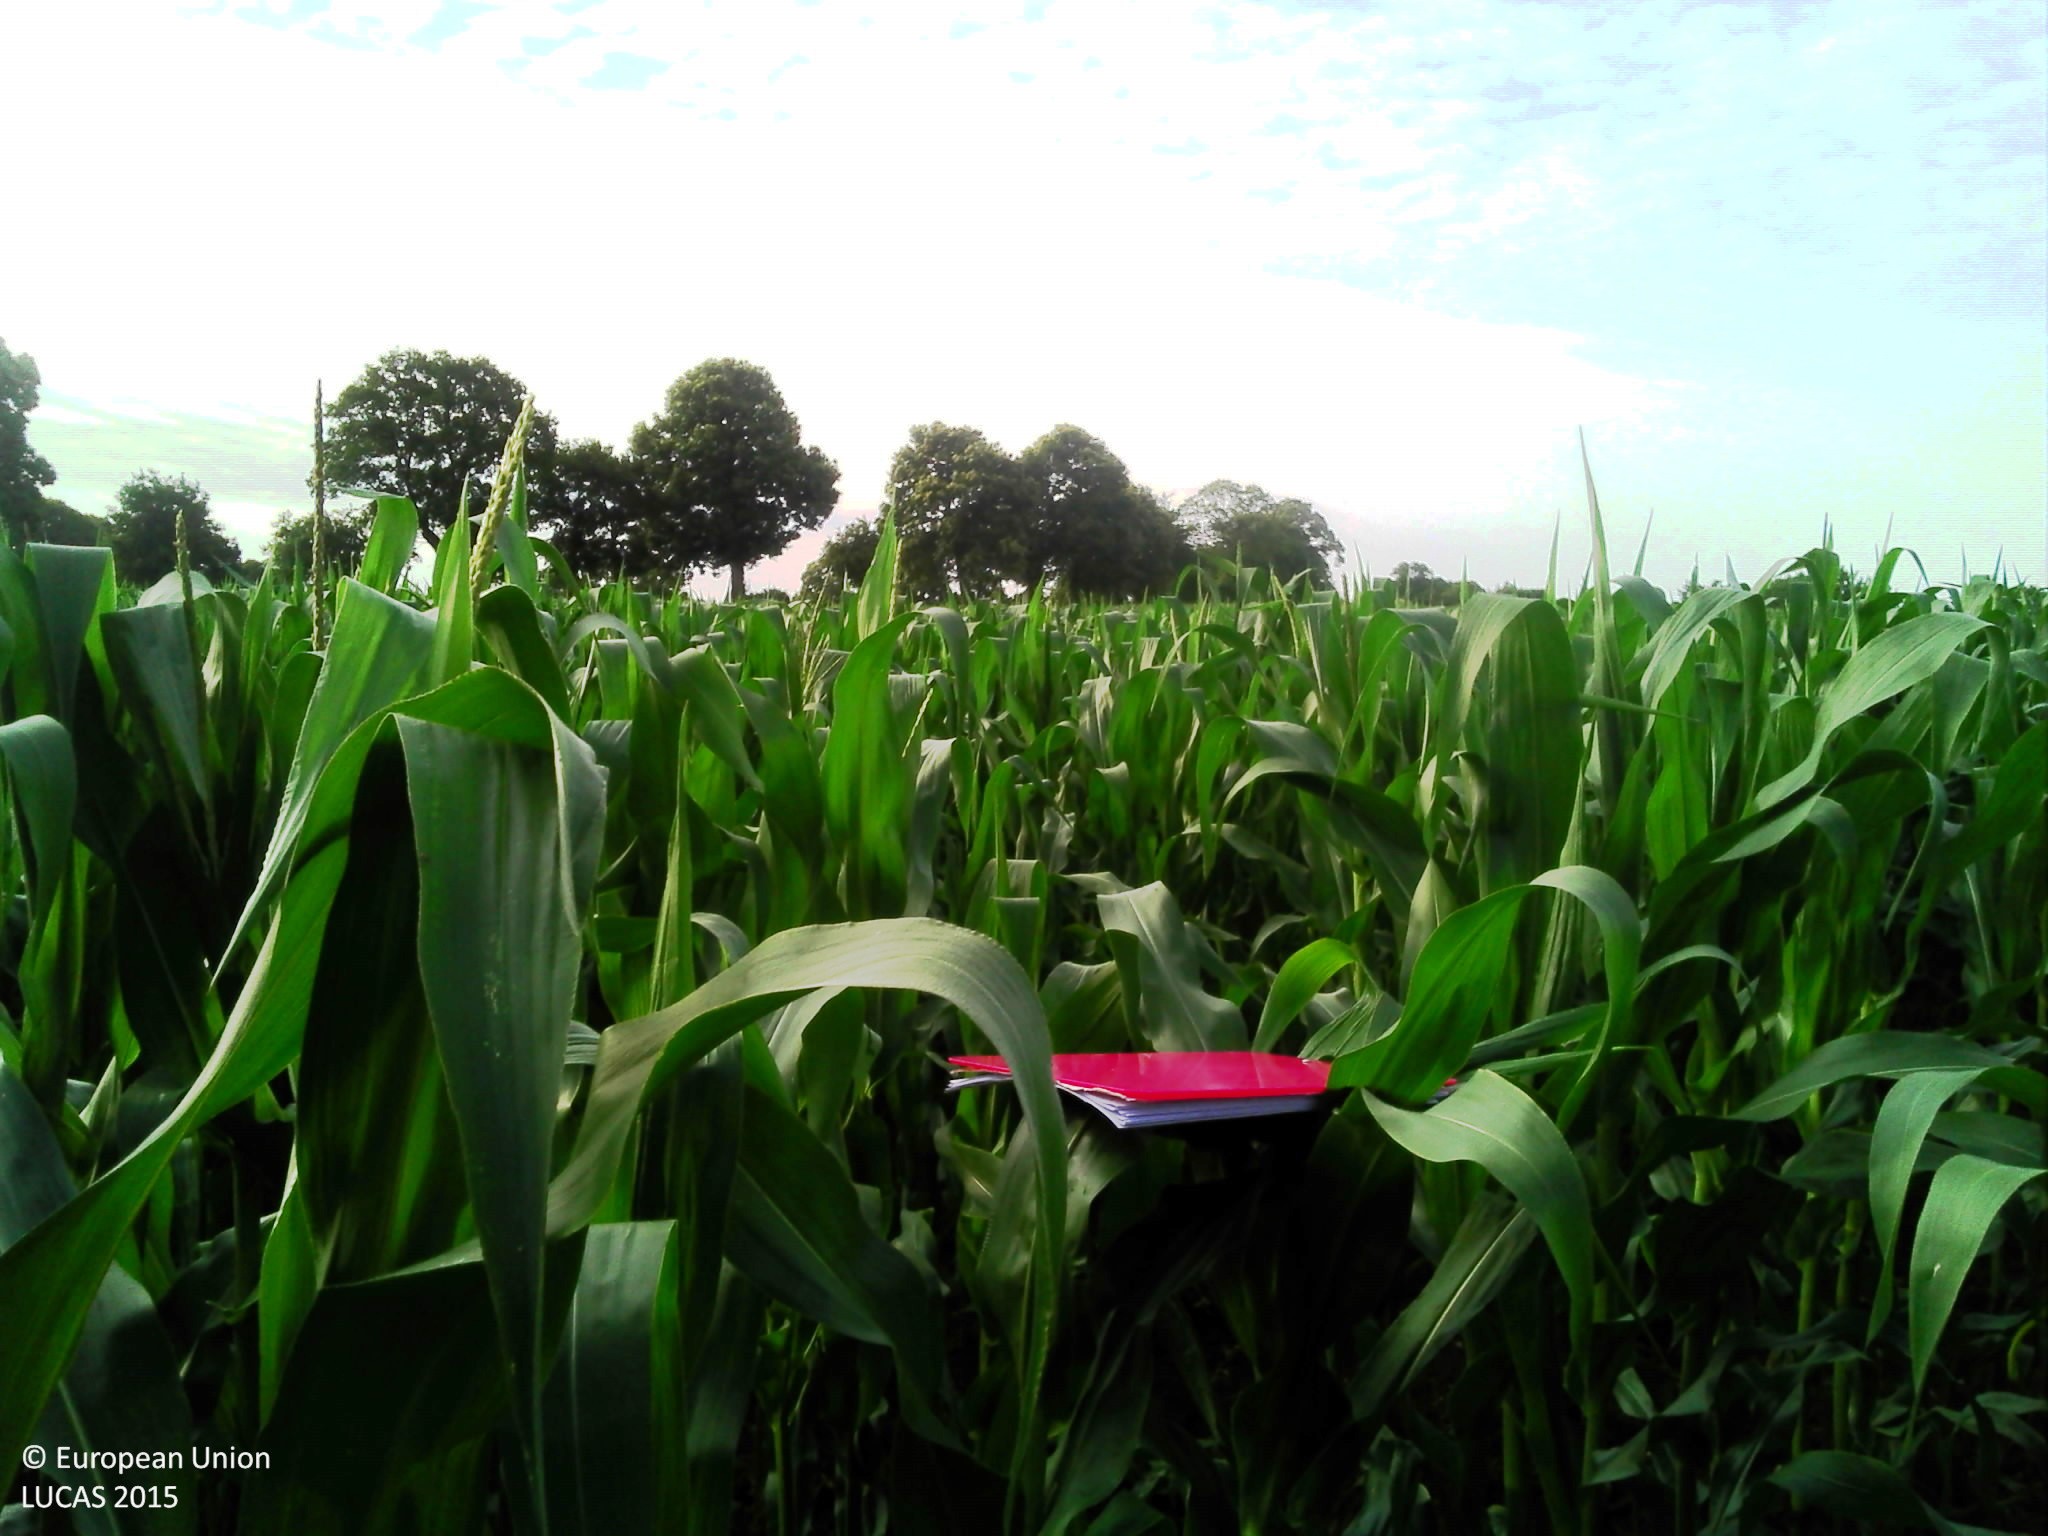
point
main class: Cropland
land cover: Maize
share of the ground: > 75 %
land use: Agriculture (excluding fallow land and kitchen gardens)
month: July
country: FR
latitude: 48.3620
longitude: -1.6972
